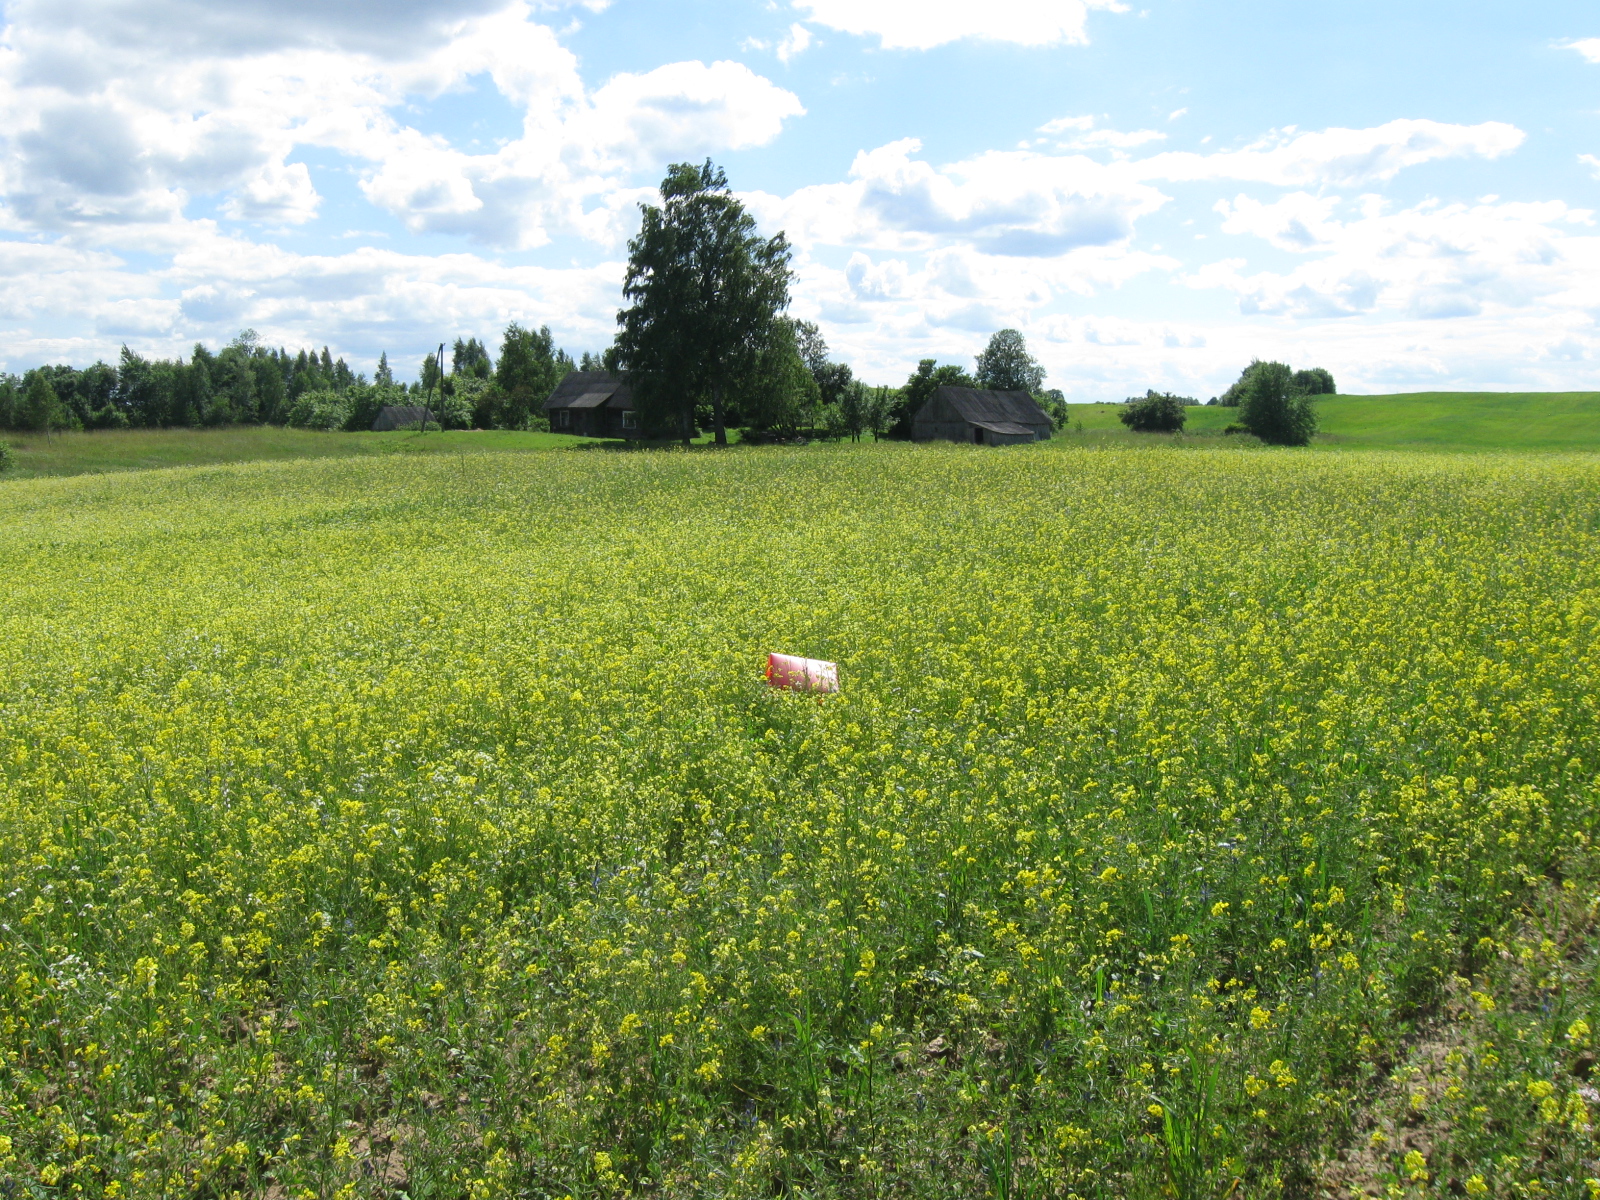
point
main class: Cropland
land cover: Dry pulses
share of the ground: > 75 %
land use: Agriculture (excluding fallow land and kitchen gardens)
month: June
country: LT
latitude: 54.5211
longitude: 24.6125
